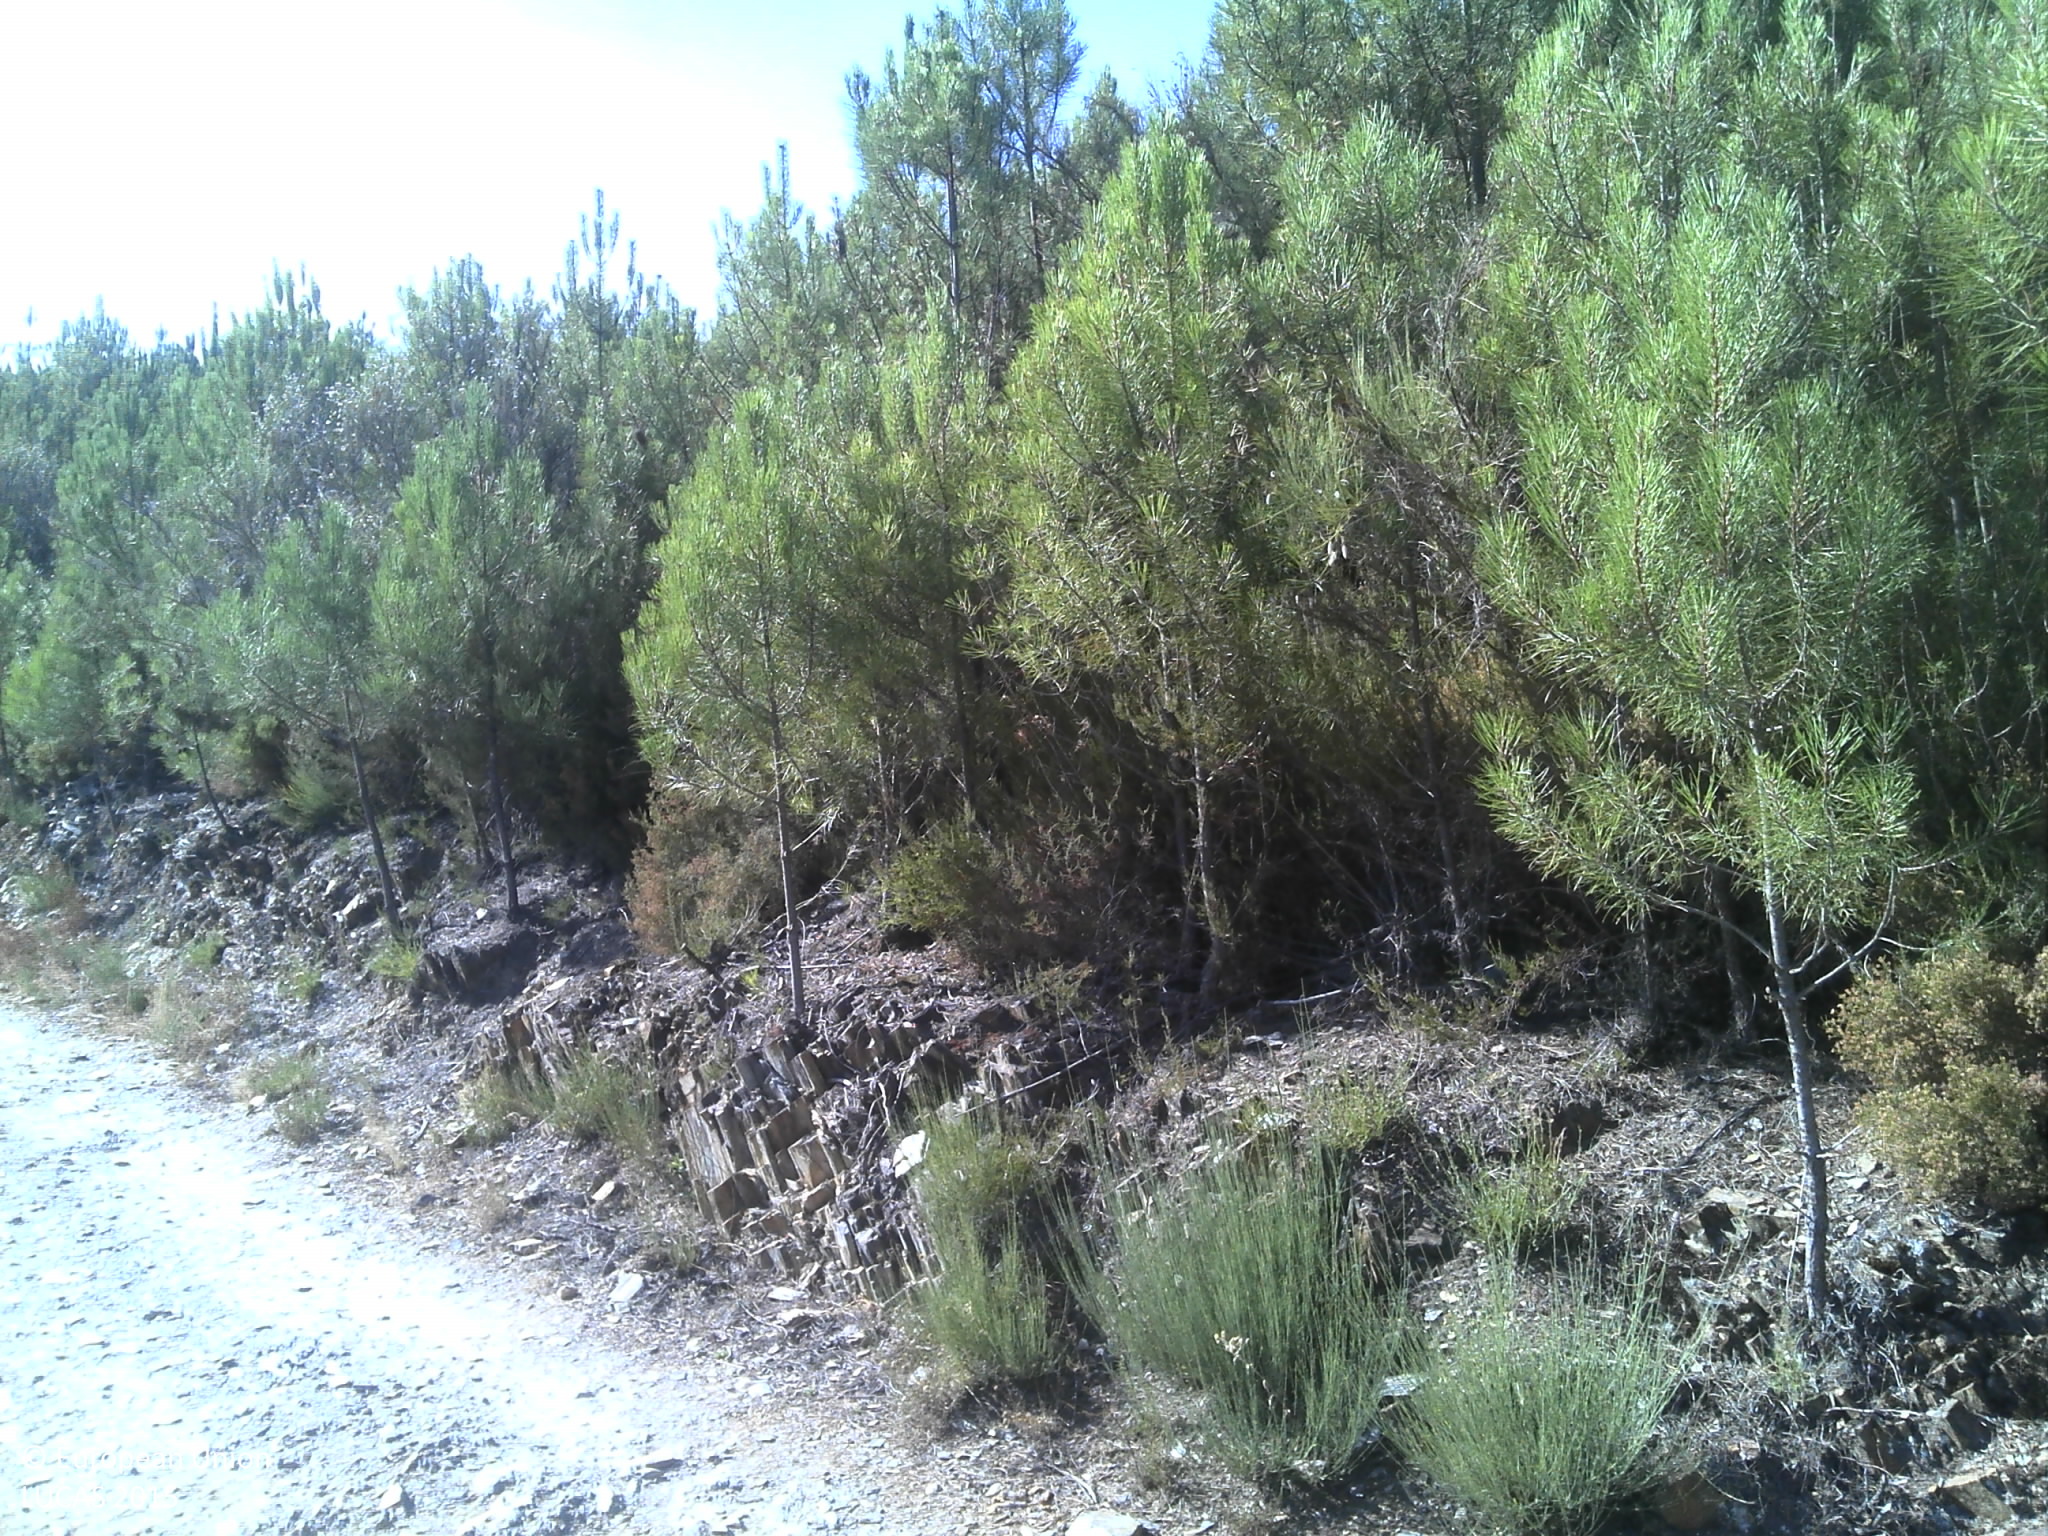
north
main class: Shrubland
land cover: Shrubland without tree cover
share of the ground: > 75 %
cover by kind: shrubs 90 %, unconsolidated bare surface 5 %
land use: Abandoned areas
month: July
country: PT
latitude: 40.1309
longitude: -7.8460
